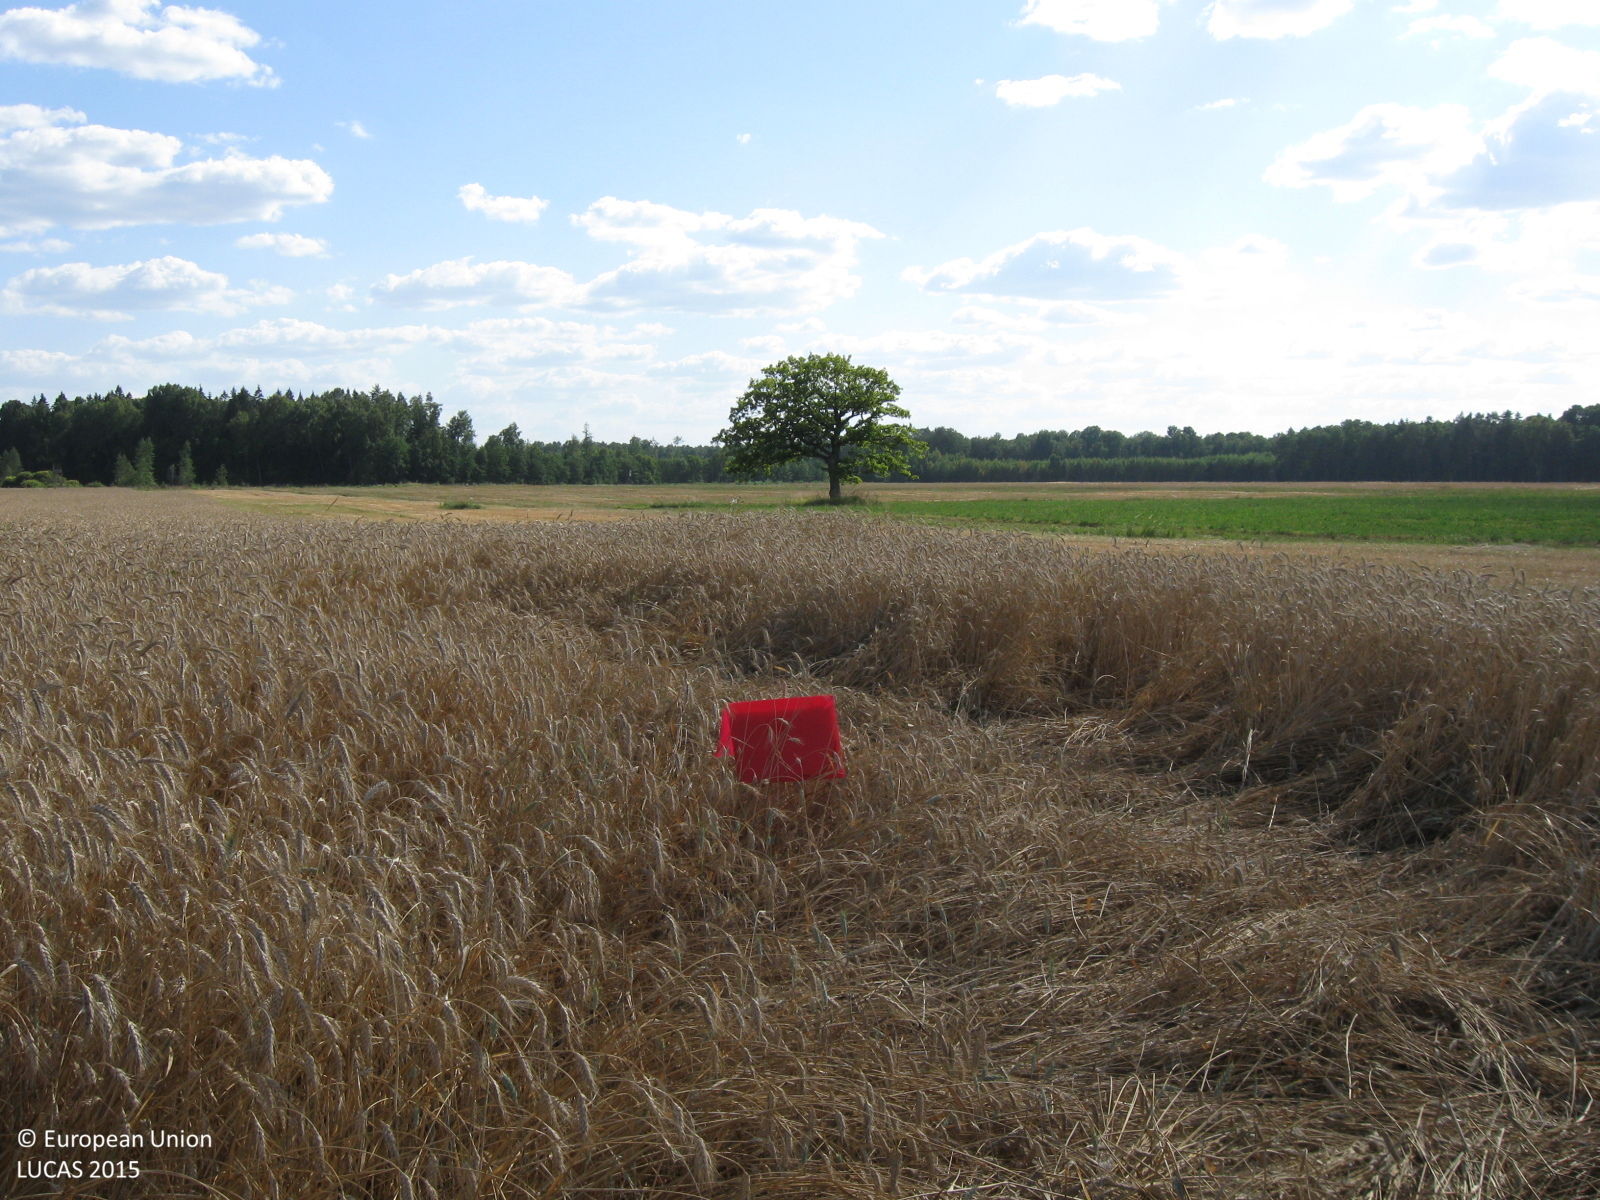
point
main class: Cropland
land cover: Triticale
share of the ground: > 75 %
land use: Agriculture (excluding fallow land and kitchen gardens)
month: August
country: LT
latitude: 55.2390
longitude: 22.5657
